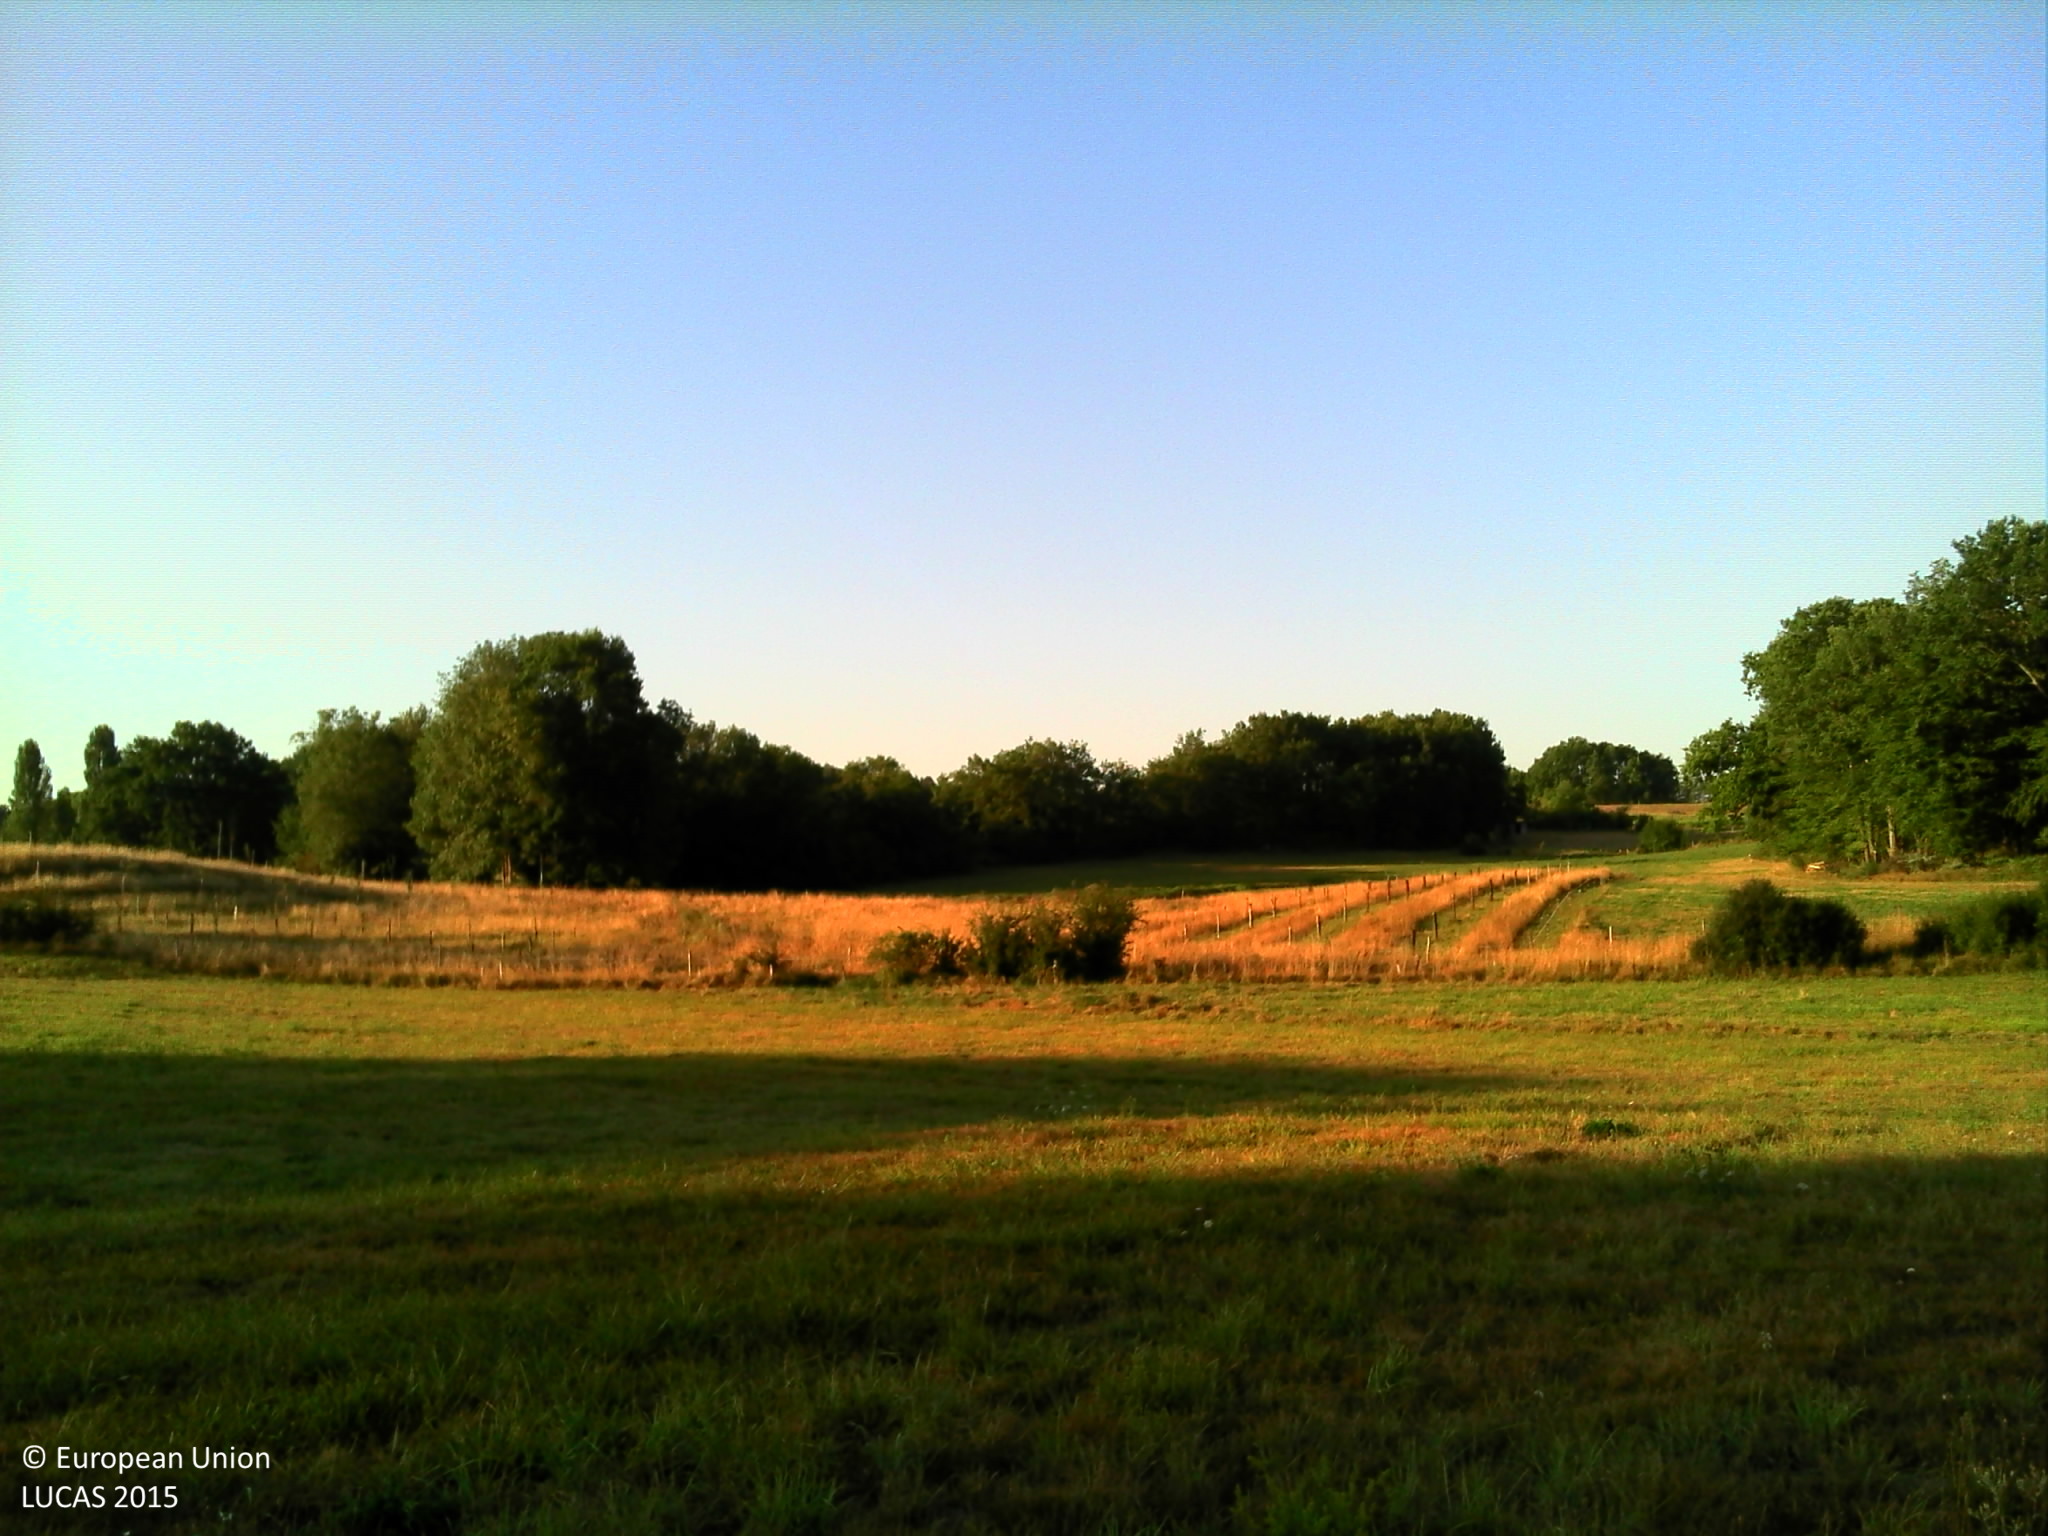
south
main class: Grassland
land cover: Grassland without tree/shrub cover
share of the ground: > 75 %
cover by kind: herbaceous plants 90 %, shrubs 5 %, lichens and mosses 5 %
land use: Agriculture (excluding fallow land and kitchen gardens)
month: August
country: FR
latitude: 44.8253
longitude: 0.7468
